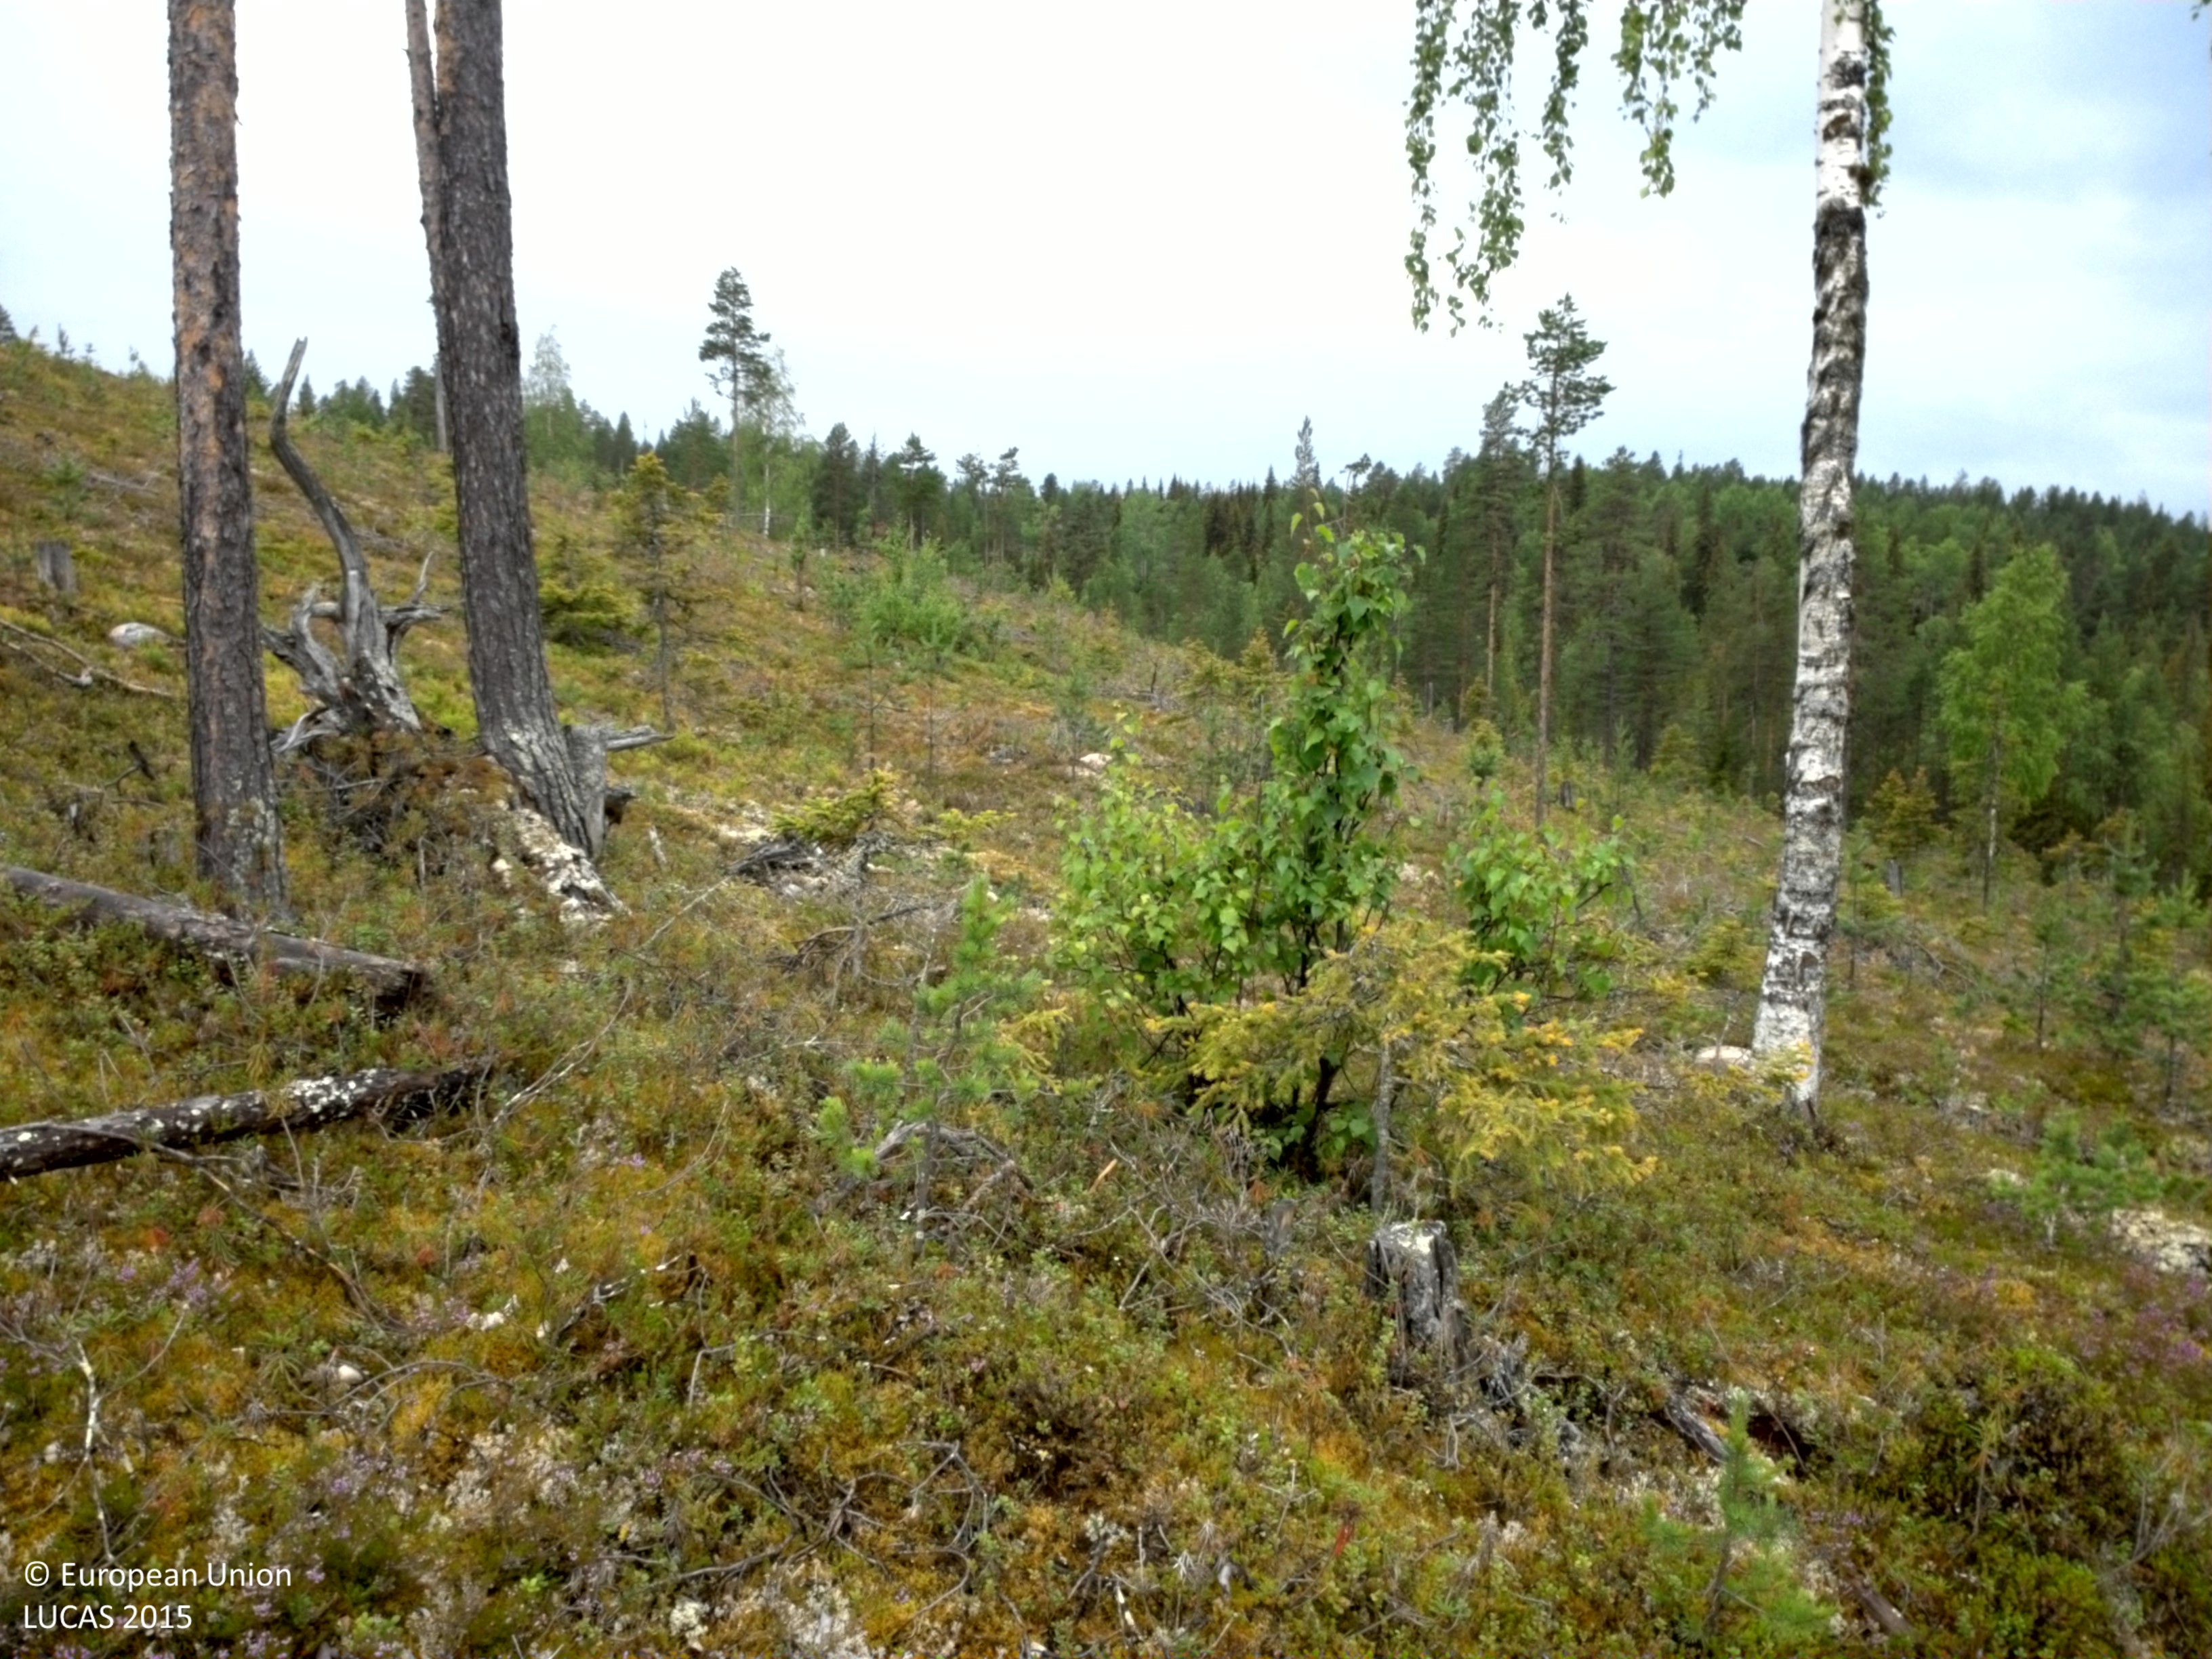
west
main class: Woodland
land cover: Pine dominated coniferous woodland
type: boreal forest
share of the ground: 10 - 25 %
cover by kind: shrubs 80 %, coniferous forest trees 10 %, lichens and mosses 10 %
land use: Forestry
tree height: < 5 m
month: August
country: SE
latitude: 66.4591
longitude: 20.5247
